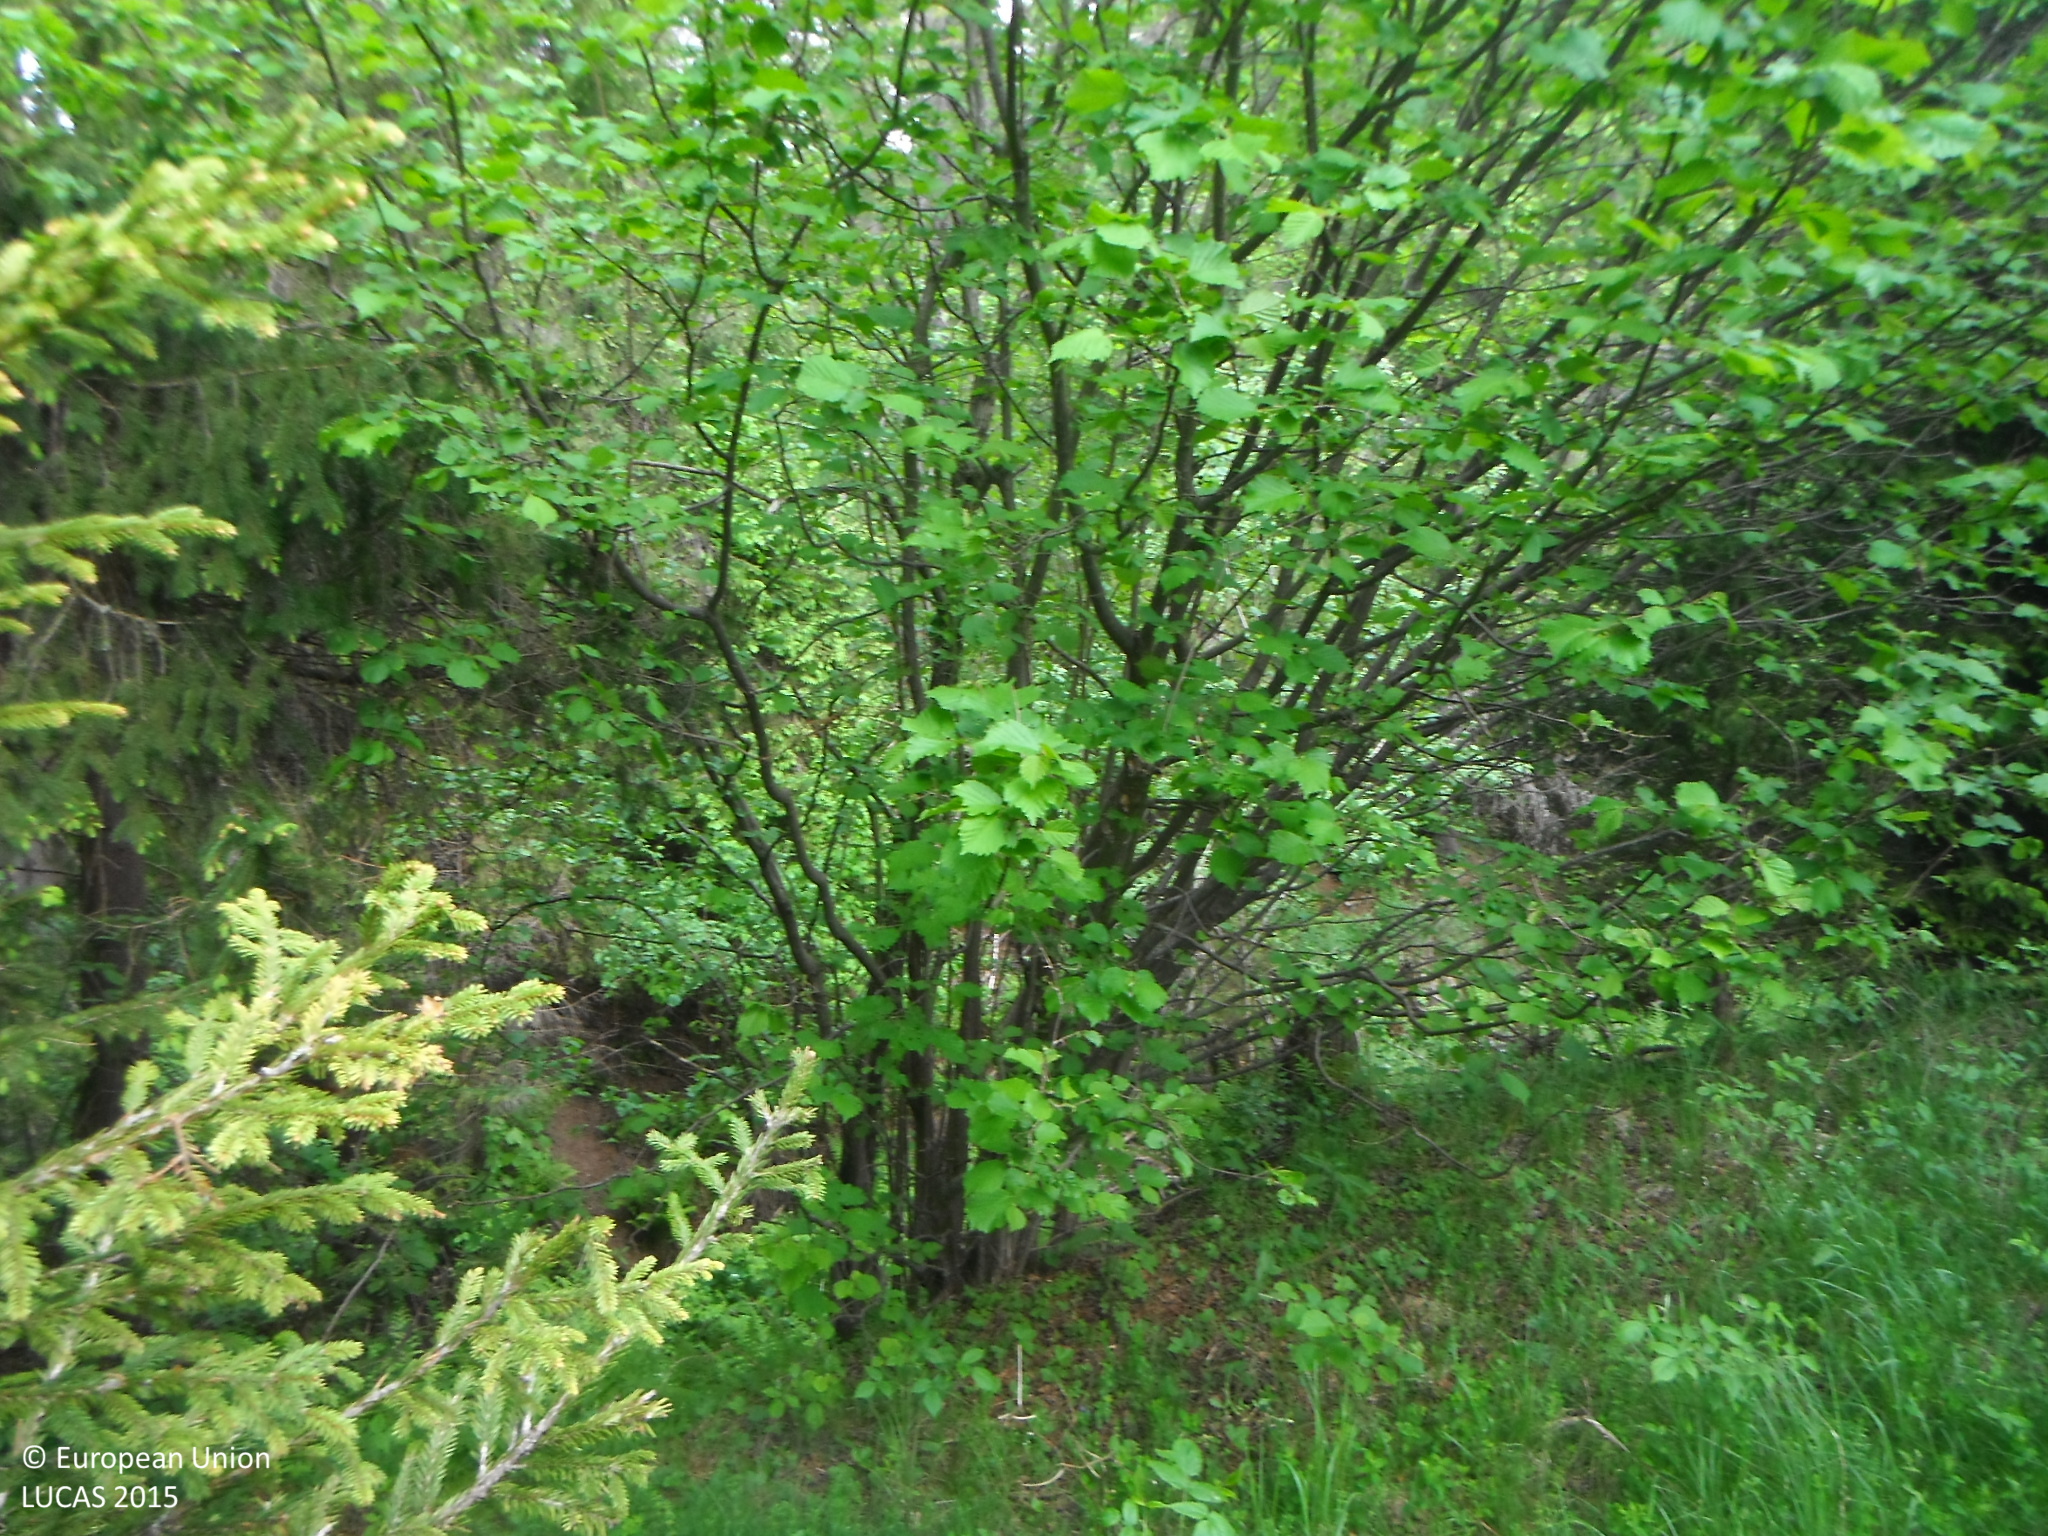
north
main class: Woodland
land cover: Other mixed woodland
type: hemiboreal forest and nemoral coniferous forest and mixed broadleaved-coniferous forest
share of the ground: > 75 %
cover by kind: broadleaved forest trees 60 %, coniferous forest trees 40 %
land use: Forestry
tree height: > 5 m
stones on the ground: 10 - 25 %
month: June
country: SK
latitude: 49.0952
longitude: 20.7348
